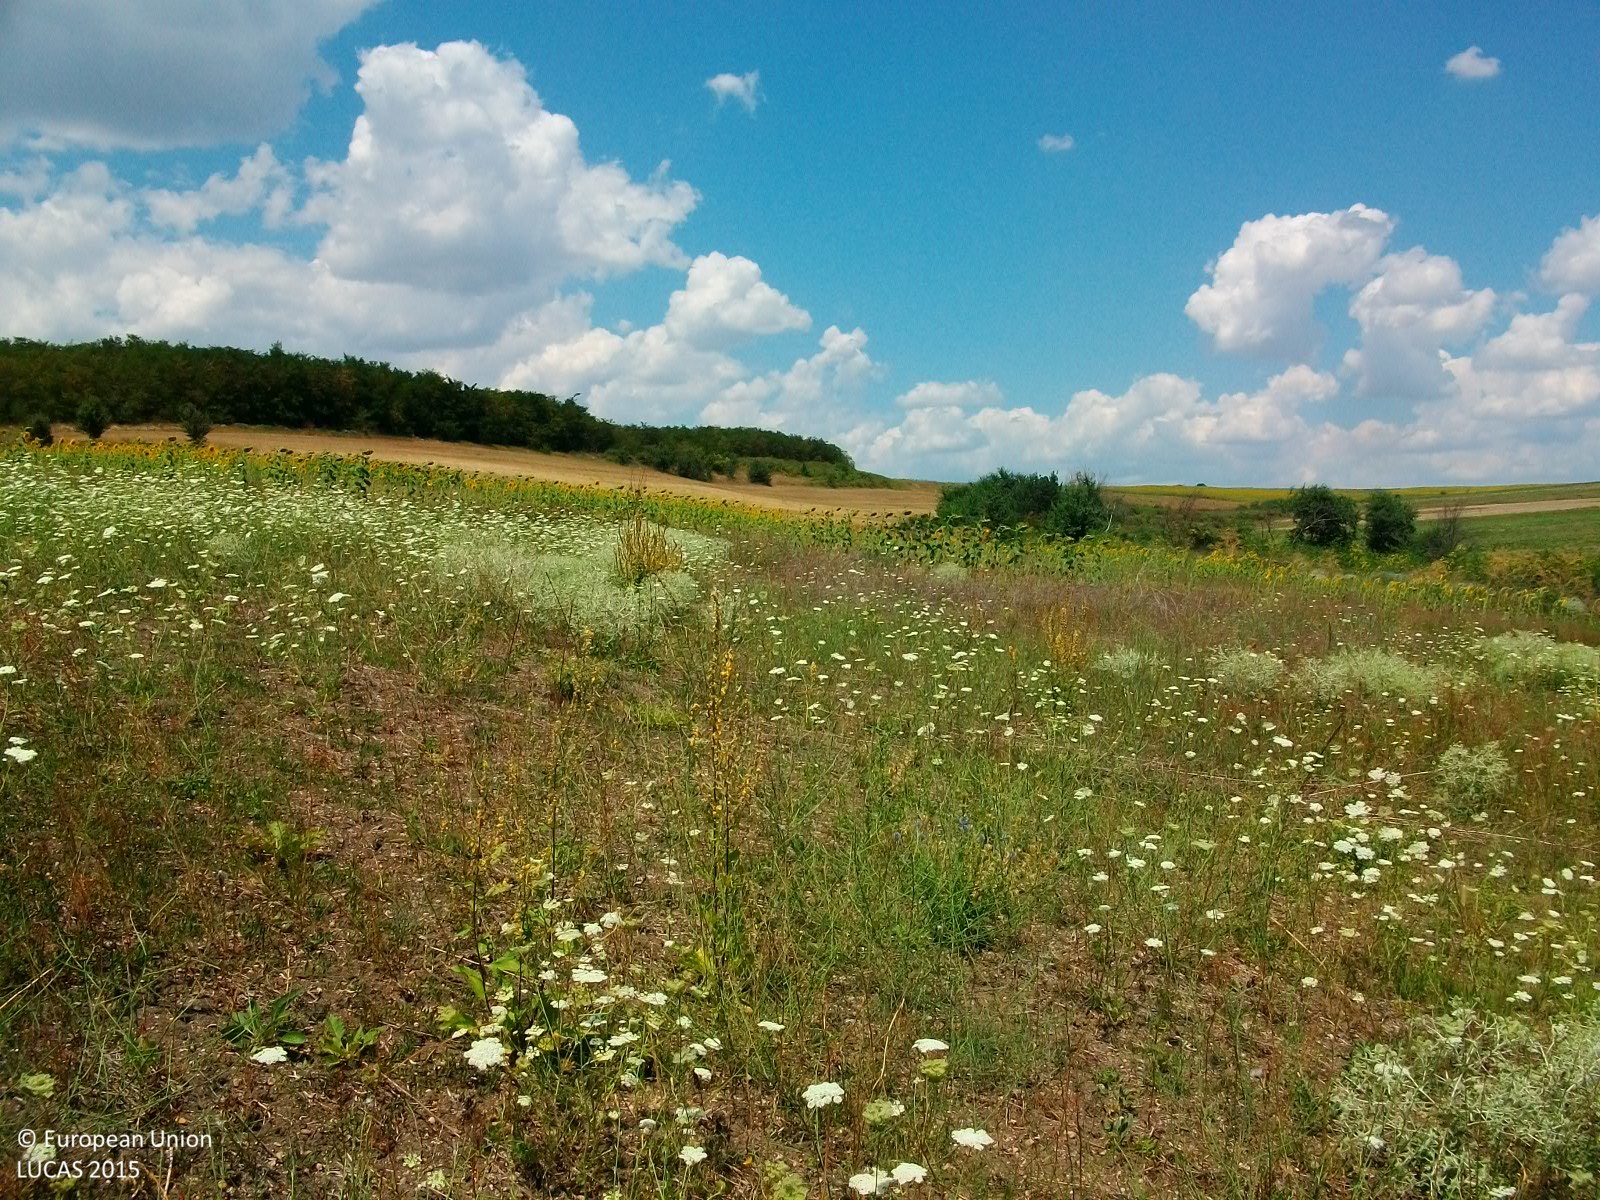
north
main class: Grassland
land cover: Spontaneously vegetated surfaces
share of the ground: > 75 %
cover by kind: herbaceous plants 100 %
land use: Fallow land
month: July
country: GR
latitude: 41.6818
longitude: 26.3558
